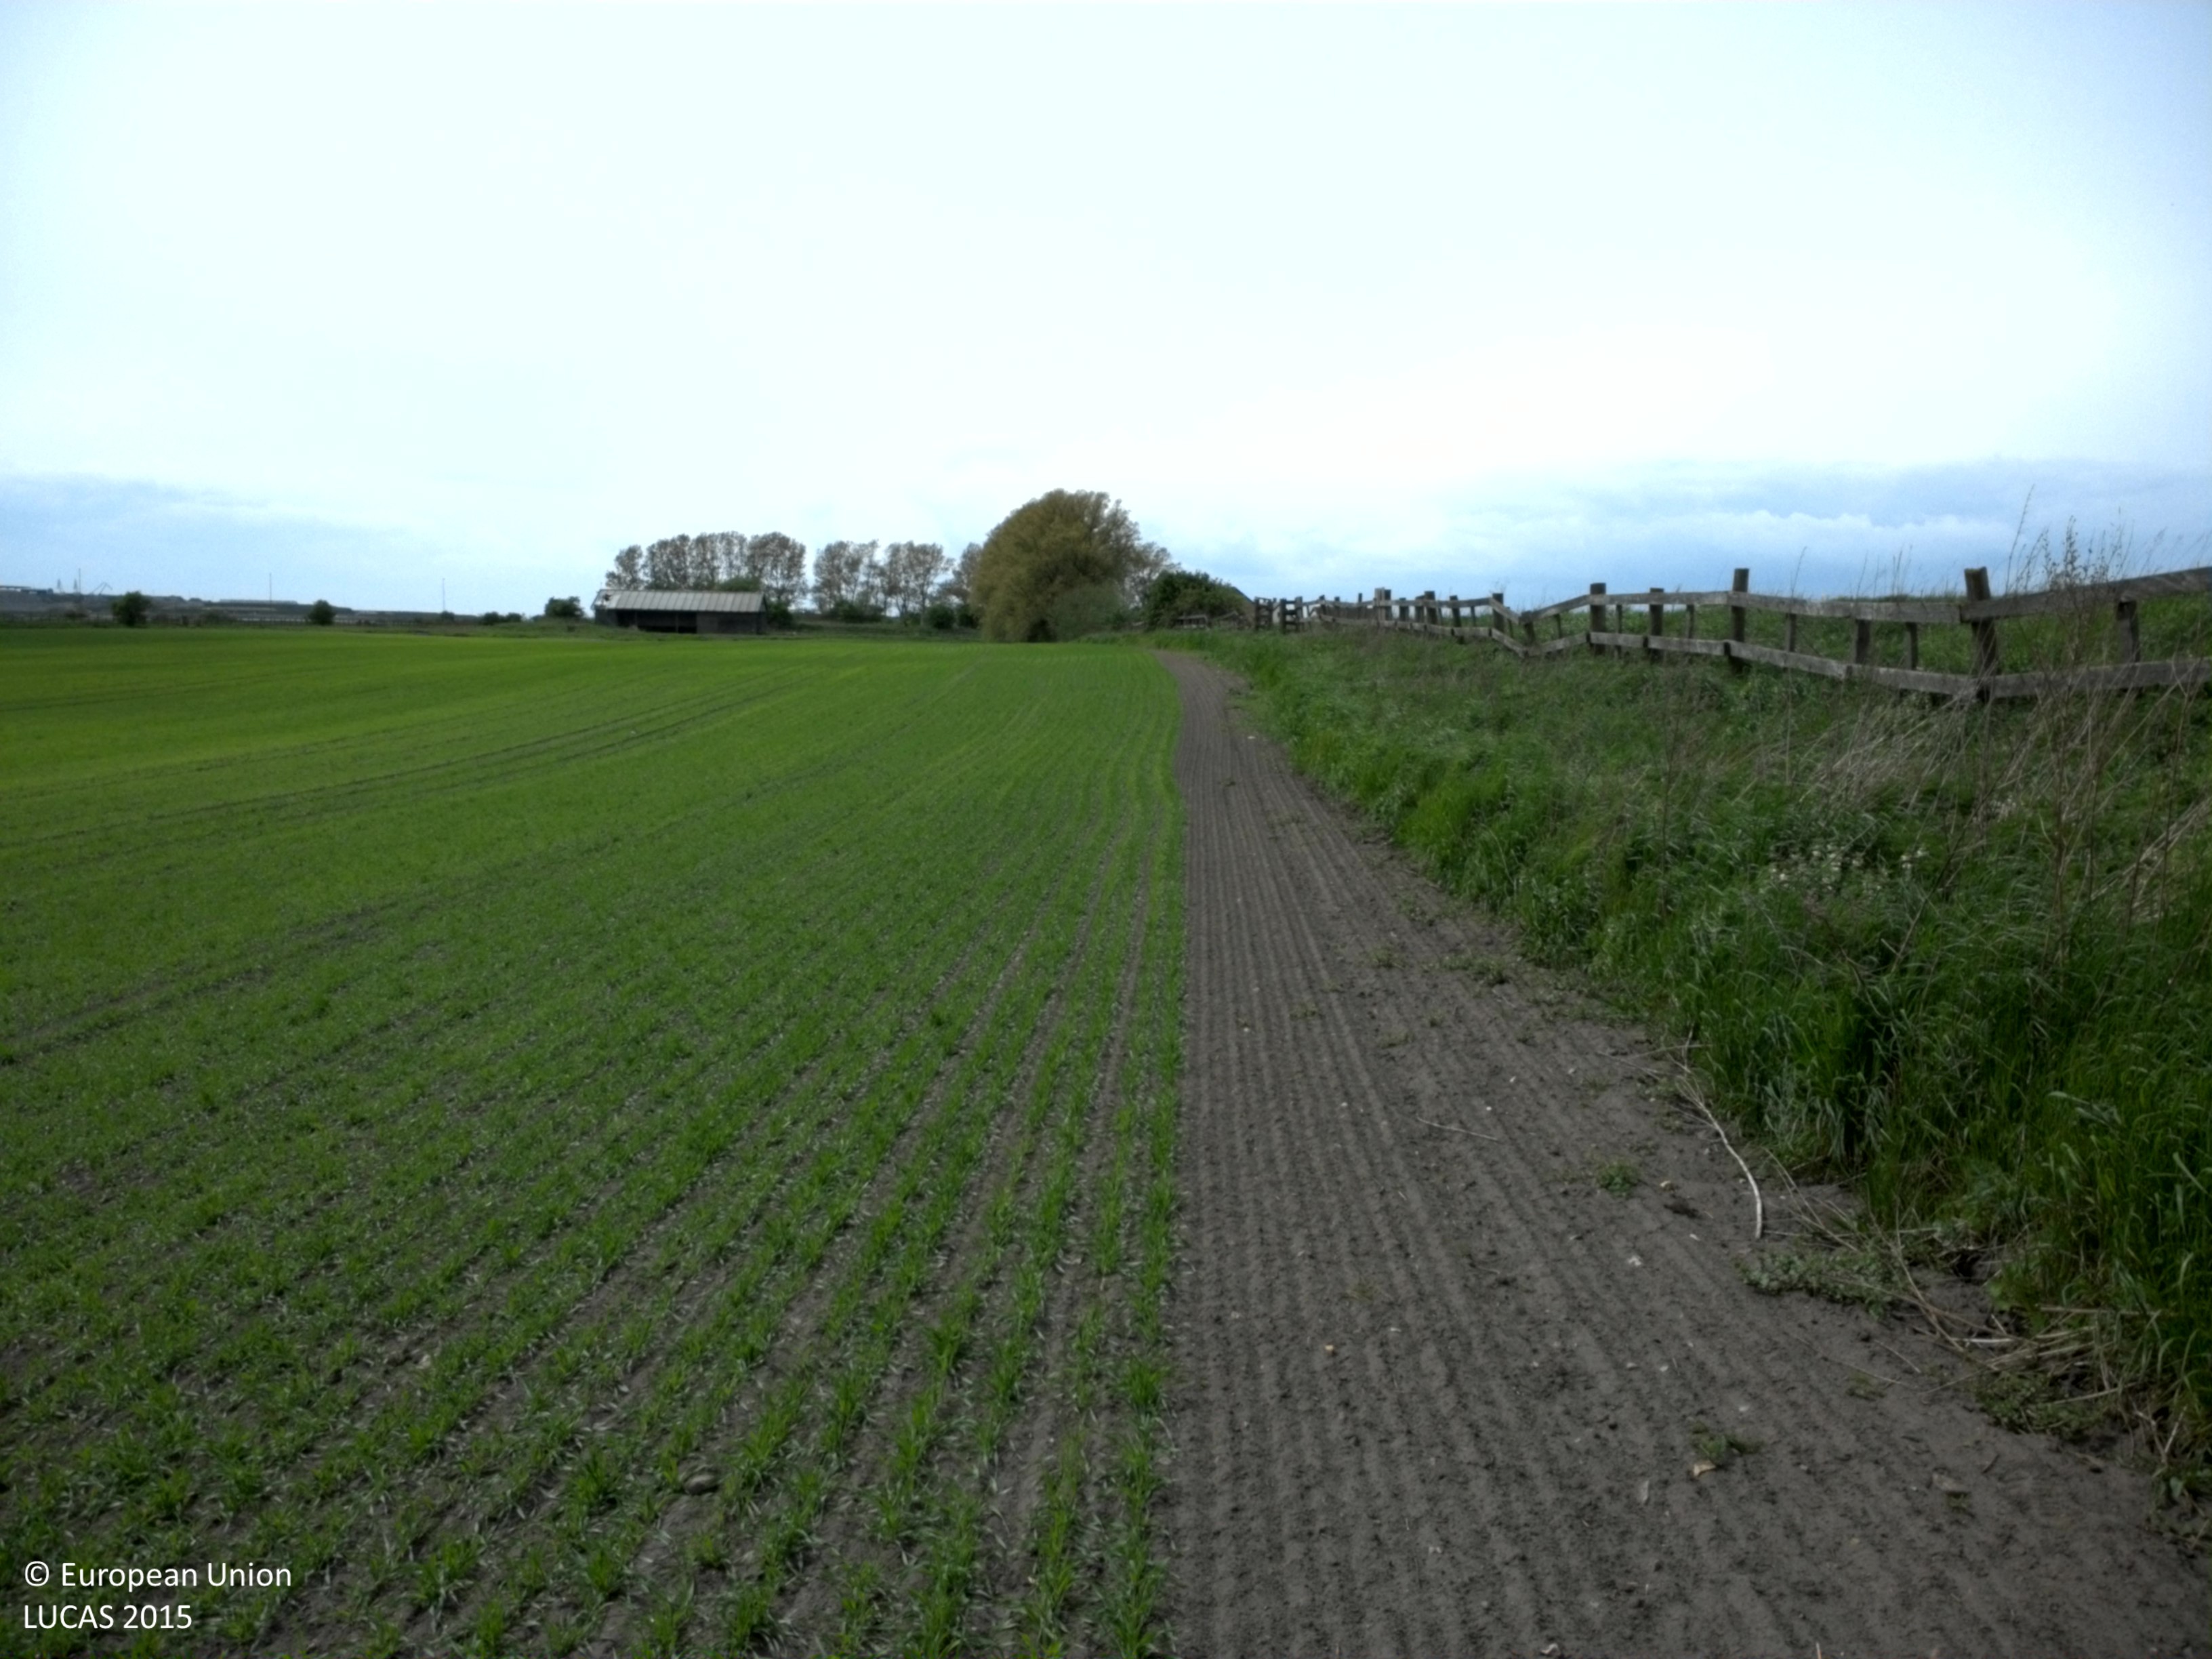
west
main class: Cropland
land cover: Barley
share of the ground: > 75 %
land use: Agriculture (excluding fallow land and kitchen gardens)
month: May
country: SE
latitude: 55.6475
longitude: 13.0648
